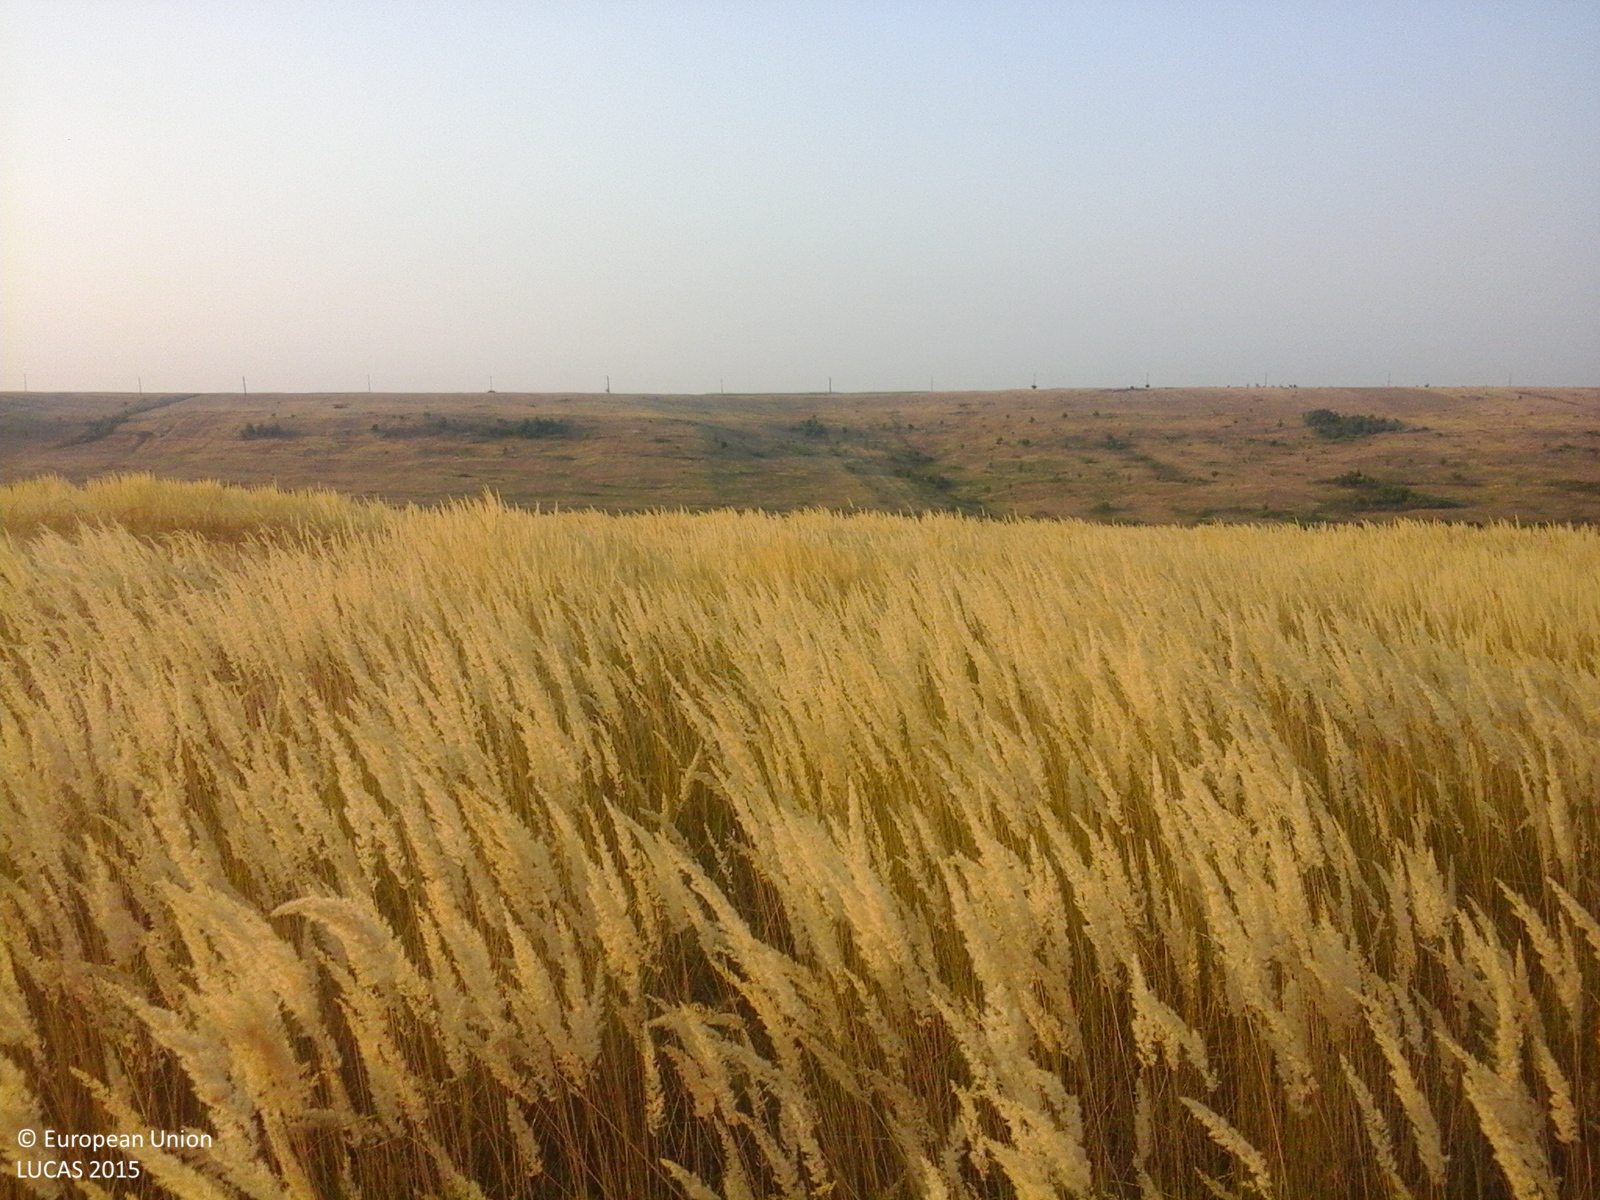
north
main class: Grassland
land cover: Grassland without tree/shrub cover
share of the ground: > 75 %
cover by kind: herbaceous plants 100 %
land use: Agriculture (excluding fallow land and kitchen gardens)
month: August
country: RO
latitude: 44.3261
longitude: 23.6091
